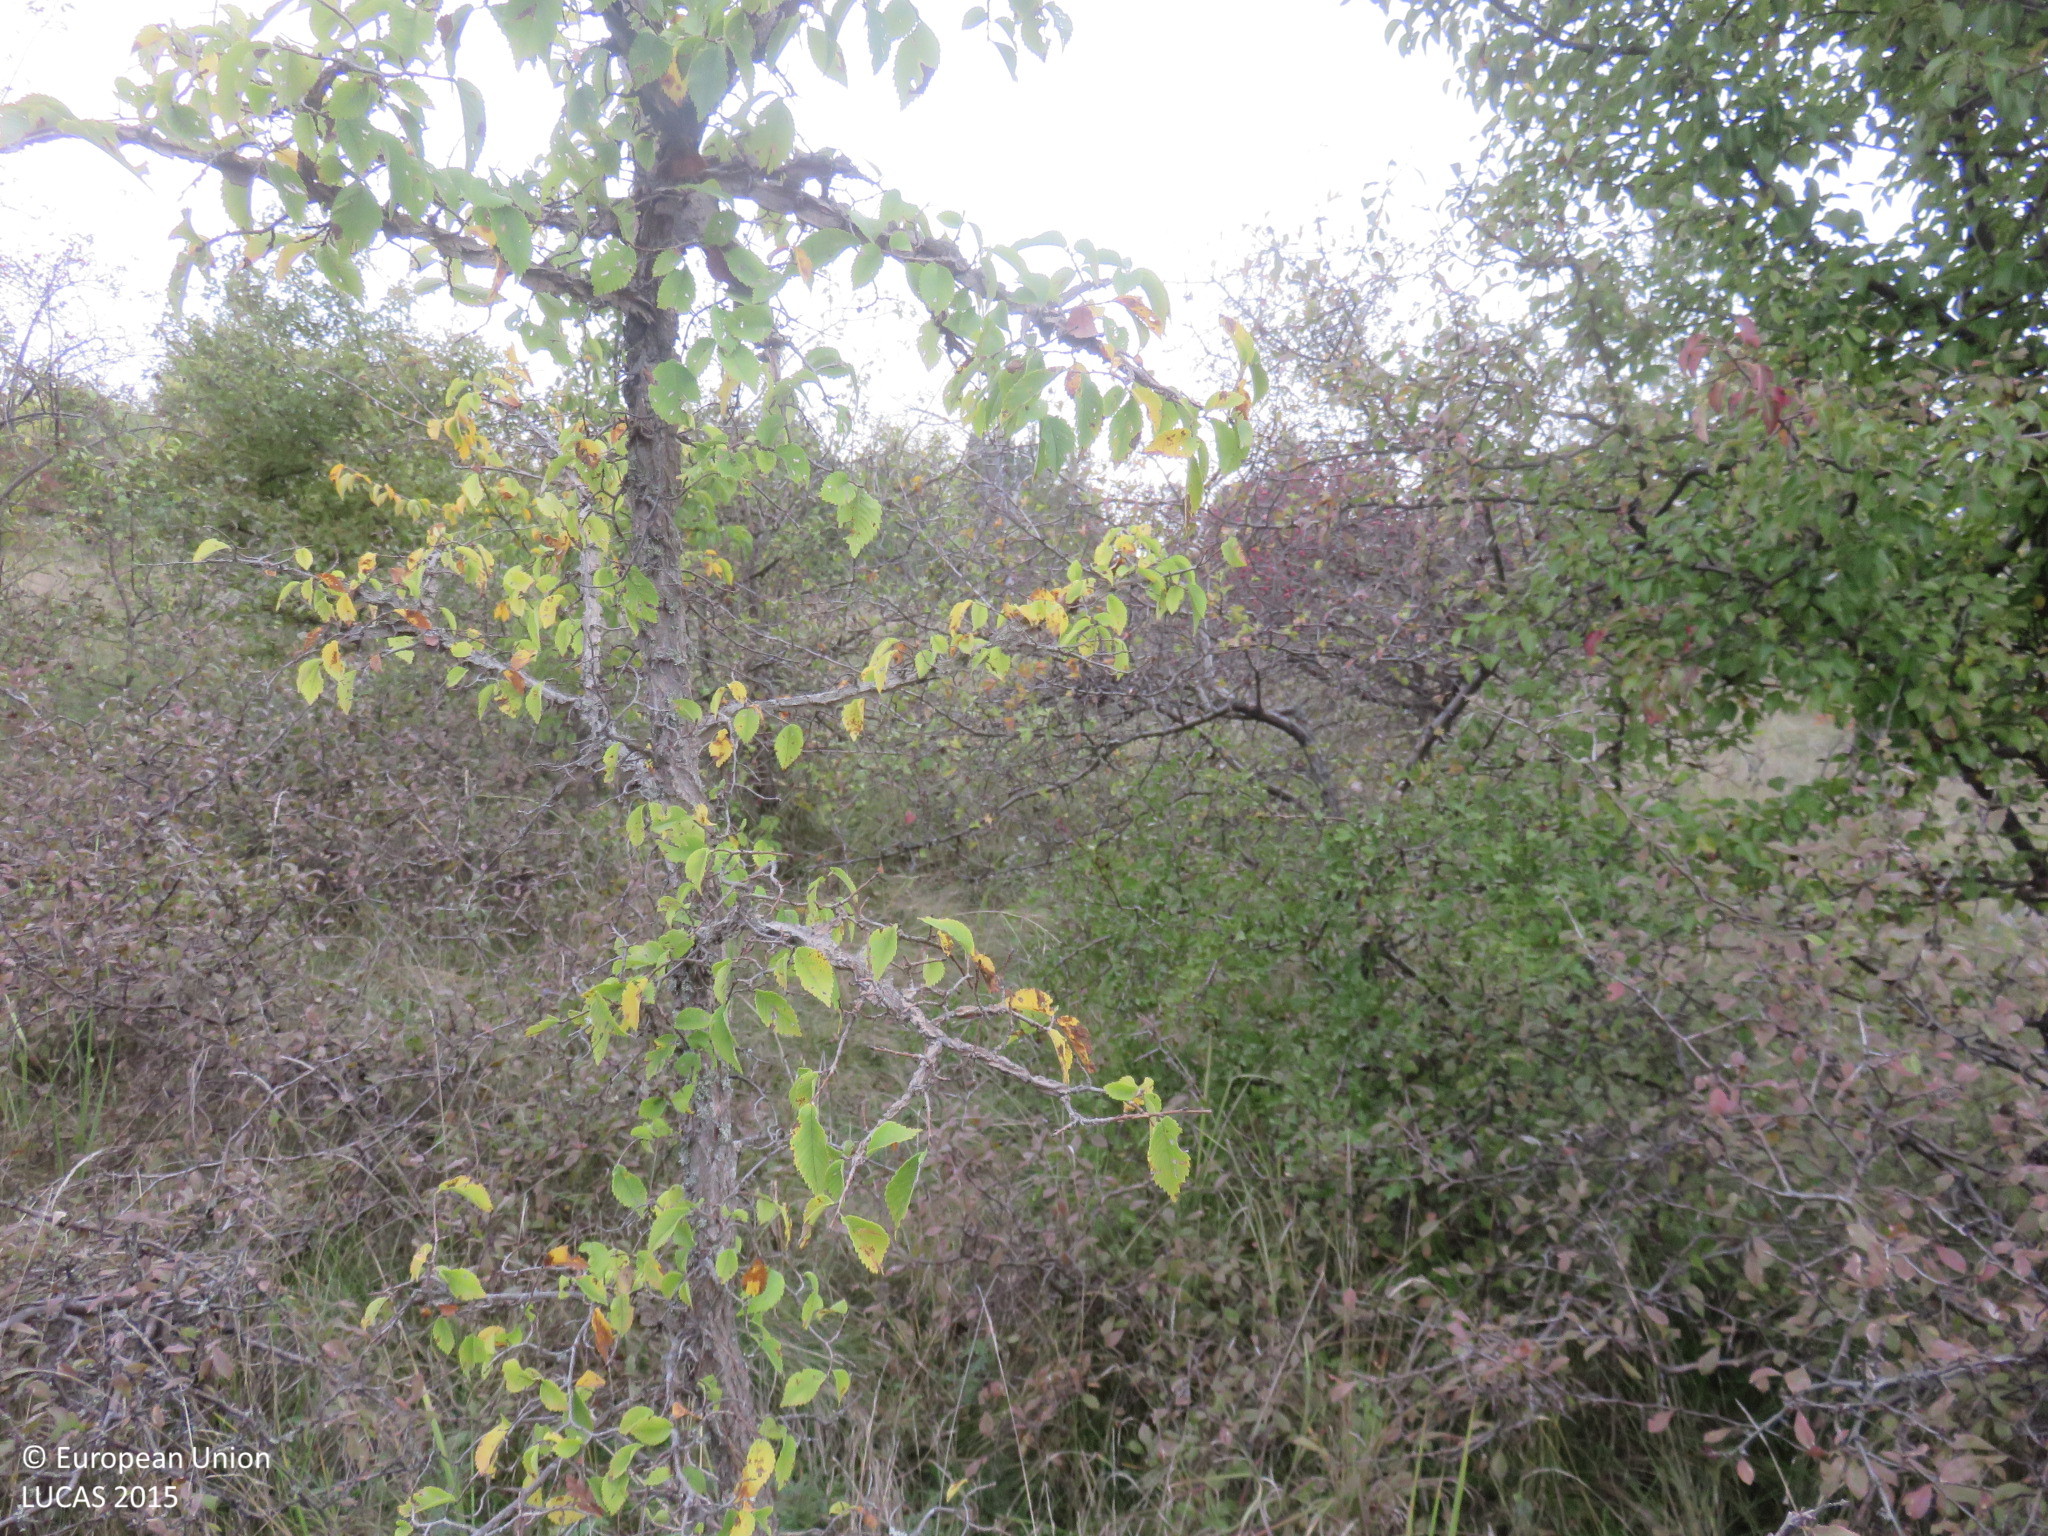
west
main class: Woodland
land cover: Broadleaved woodland
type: mesophytic deciduous forest
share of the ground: 10 - 25 %
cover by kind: shrubs 40 %, herbaceous plants 40 %, broadleaved forest trees 15 %, coniferous forest trees 5 %
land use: Semi-natural and natural areas not in use
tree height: < 5 m
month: October
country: BG
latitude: 42.9933
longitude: 25.1428
